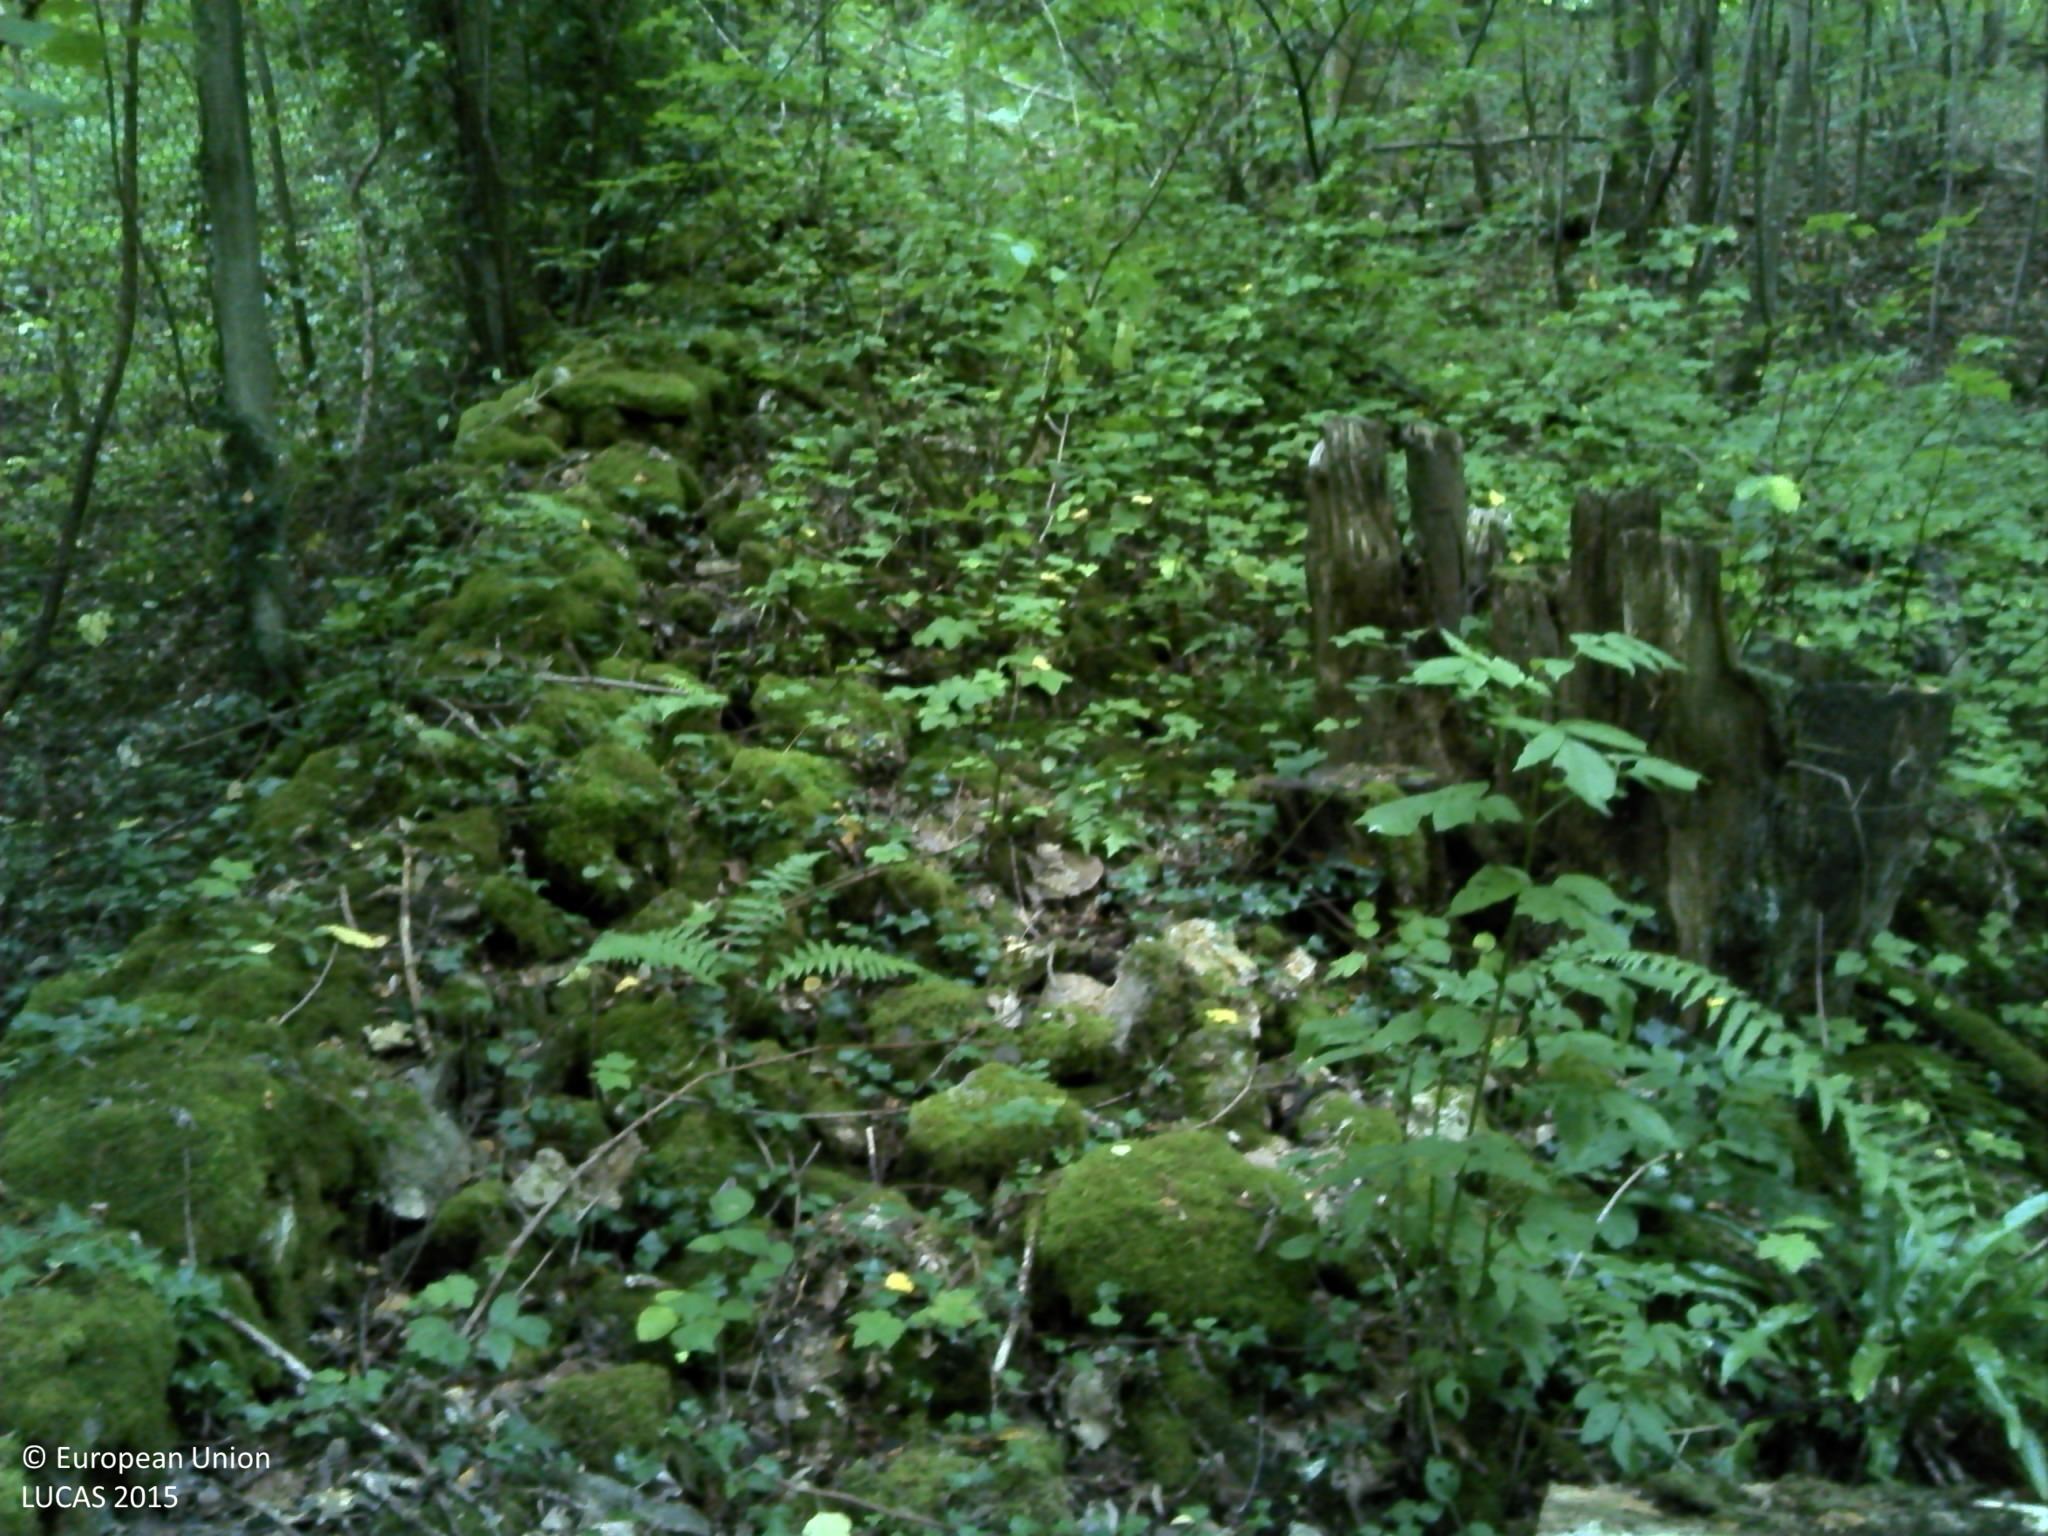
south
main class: Woodland
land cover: Broadleaved woodland
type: mesophytic deciduous forest
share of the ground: > 75 %
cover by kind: broadleaved forest trees 95 %, herbaceous plants 5 %
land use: Forestry
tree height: > 5 m
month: July
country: FR
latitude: 48.7524
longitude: 1.8377
